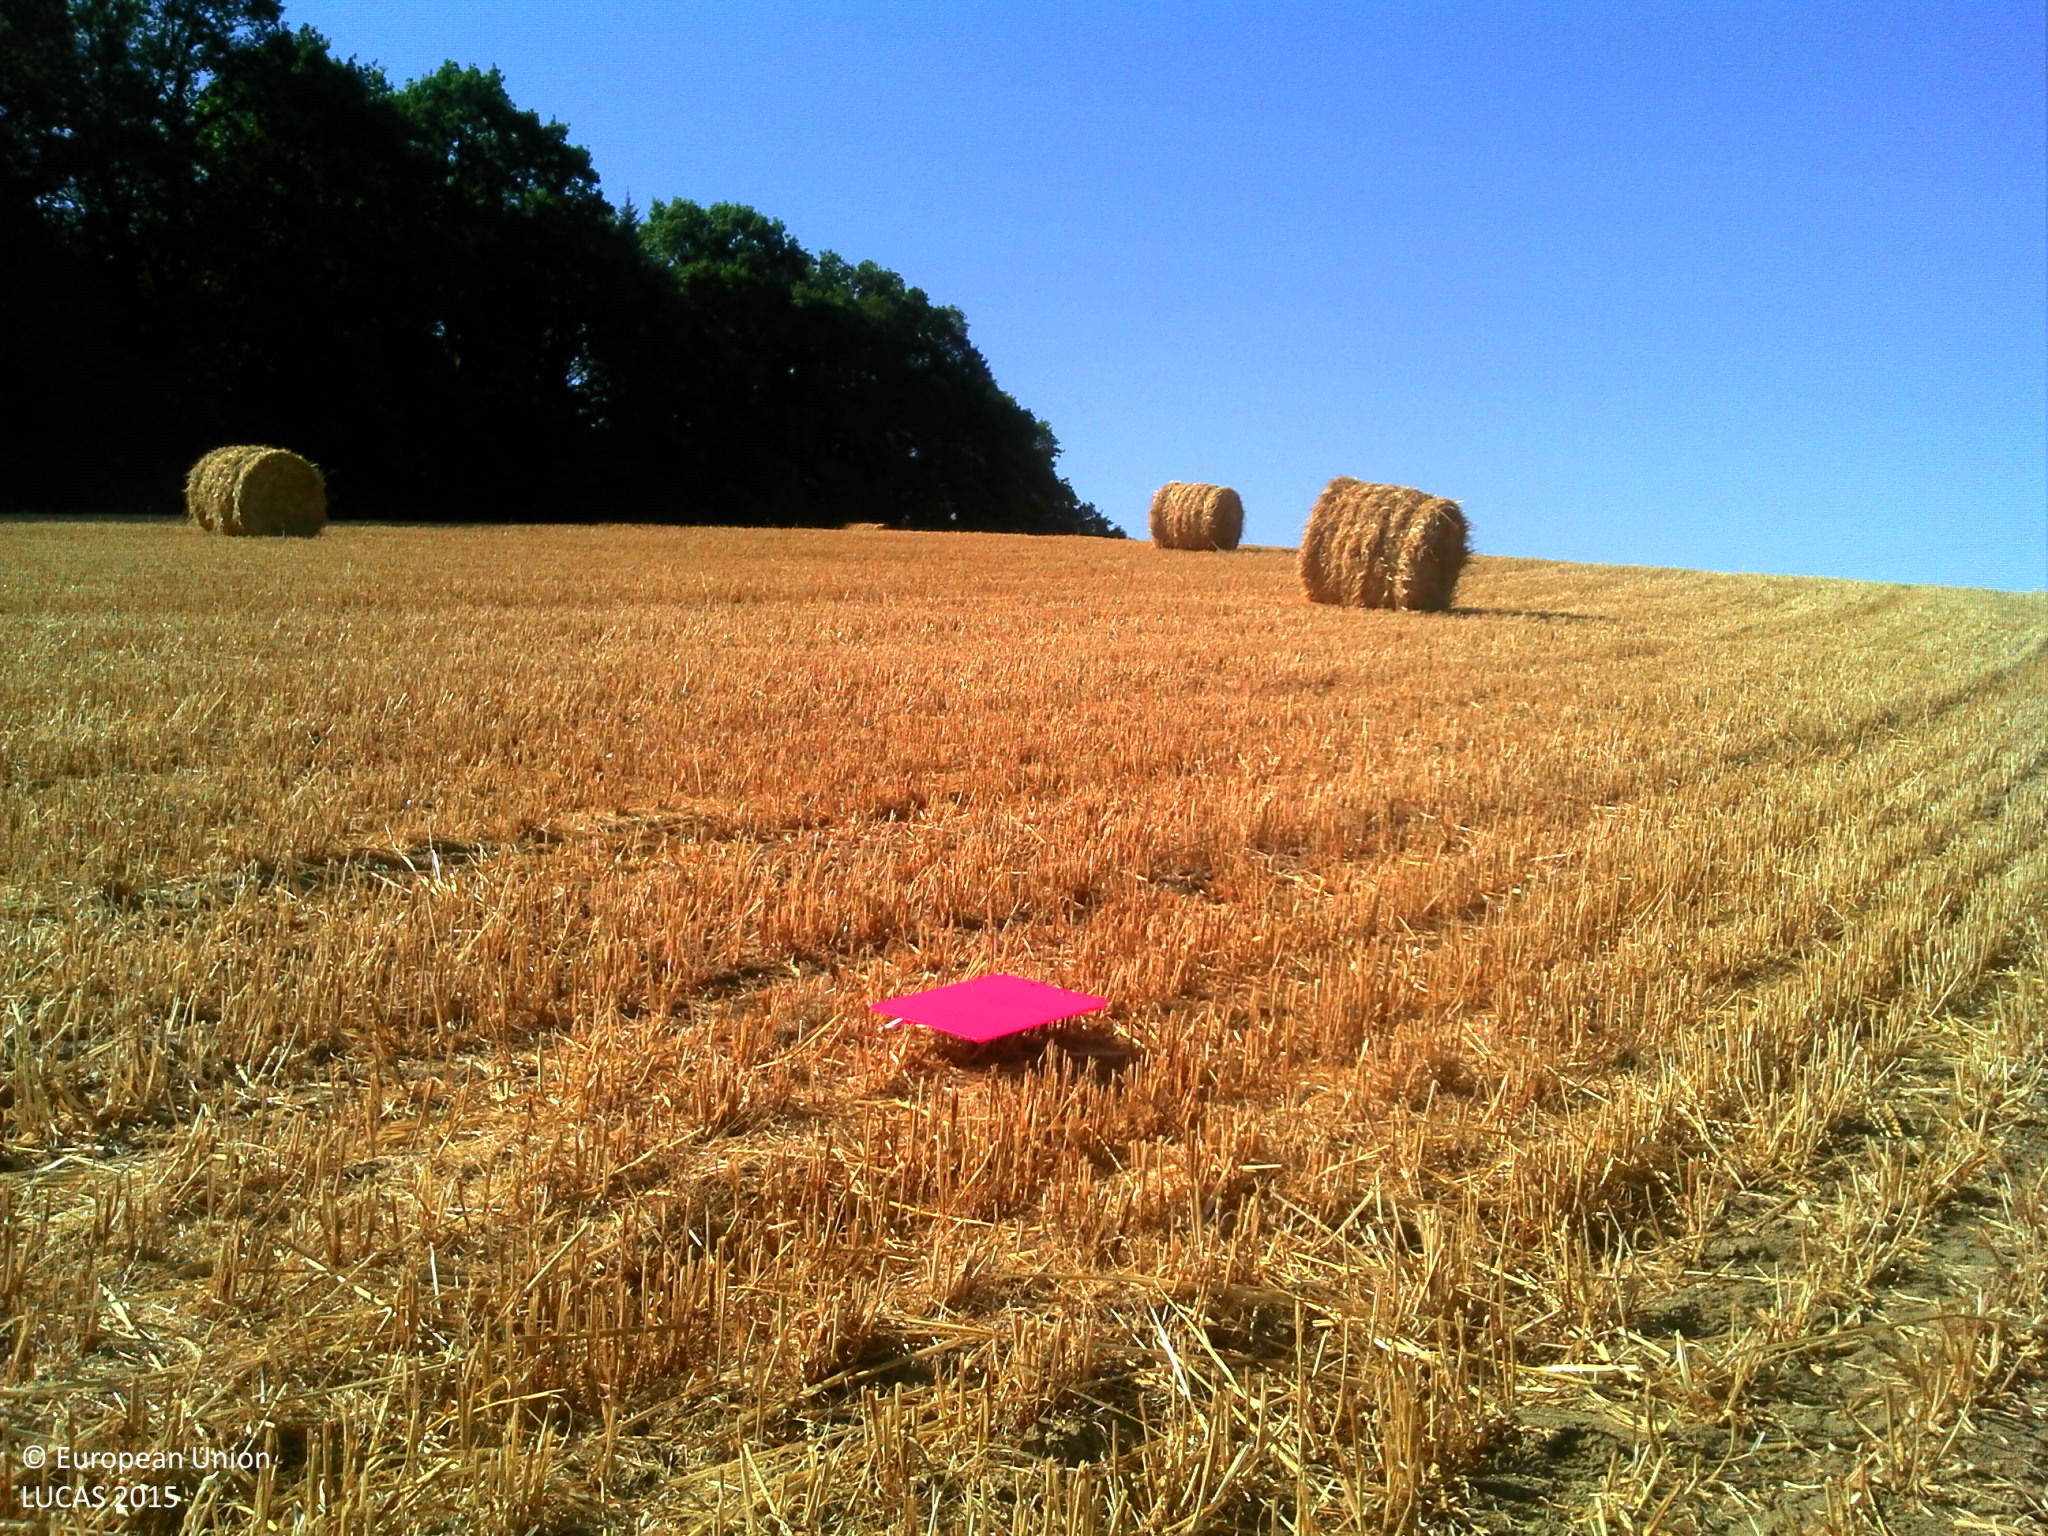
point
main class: Cropland
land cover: Durum wheat
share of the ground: > 75 %
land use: Agriculture (excluding fallow land and kitchen gardens)
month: July
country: FR
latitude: 45.6112
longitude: 1.4657
